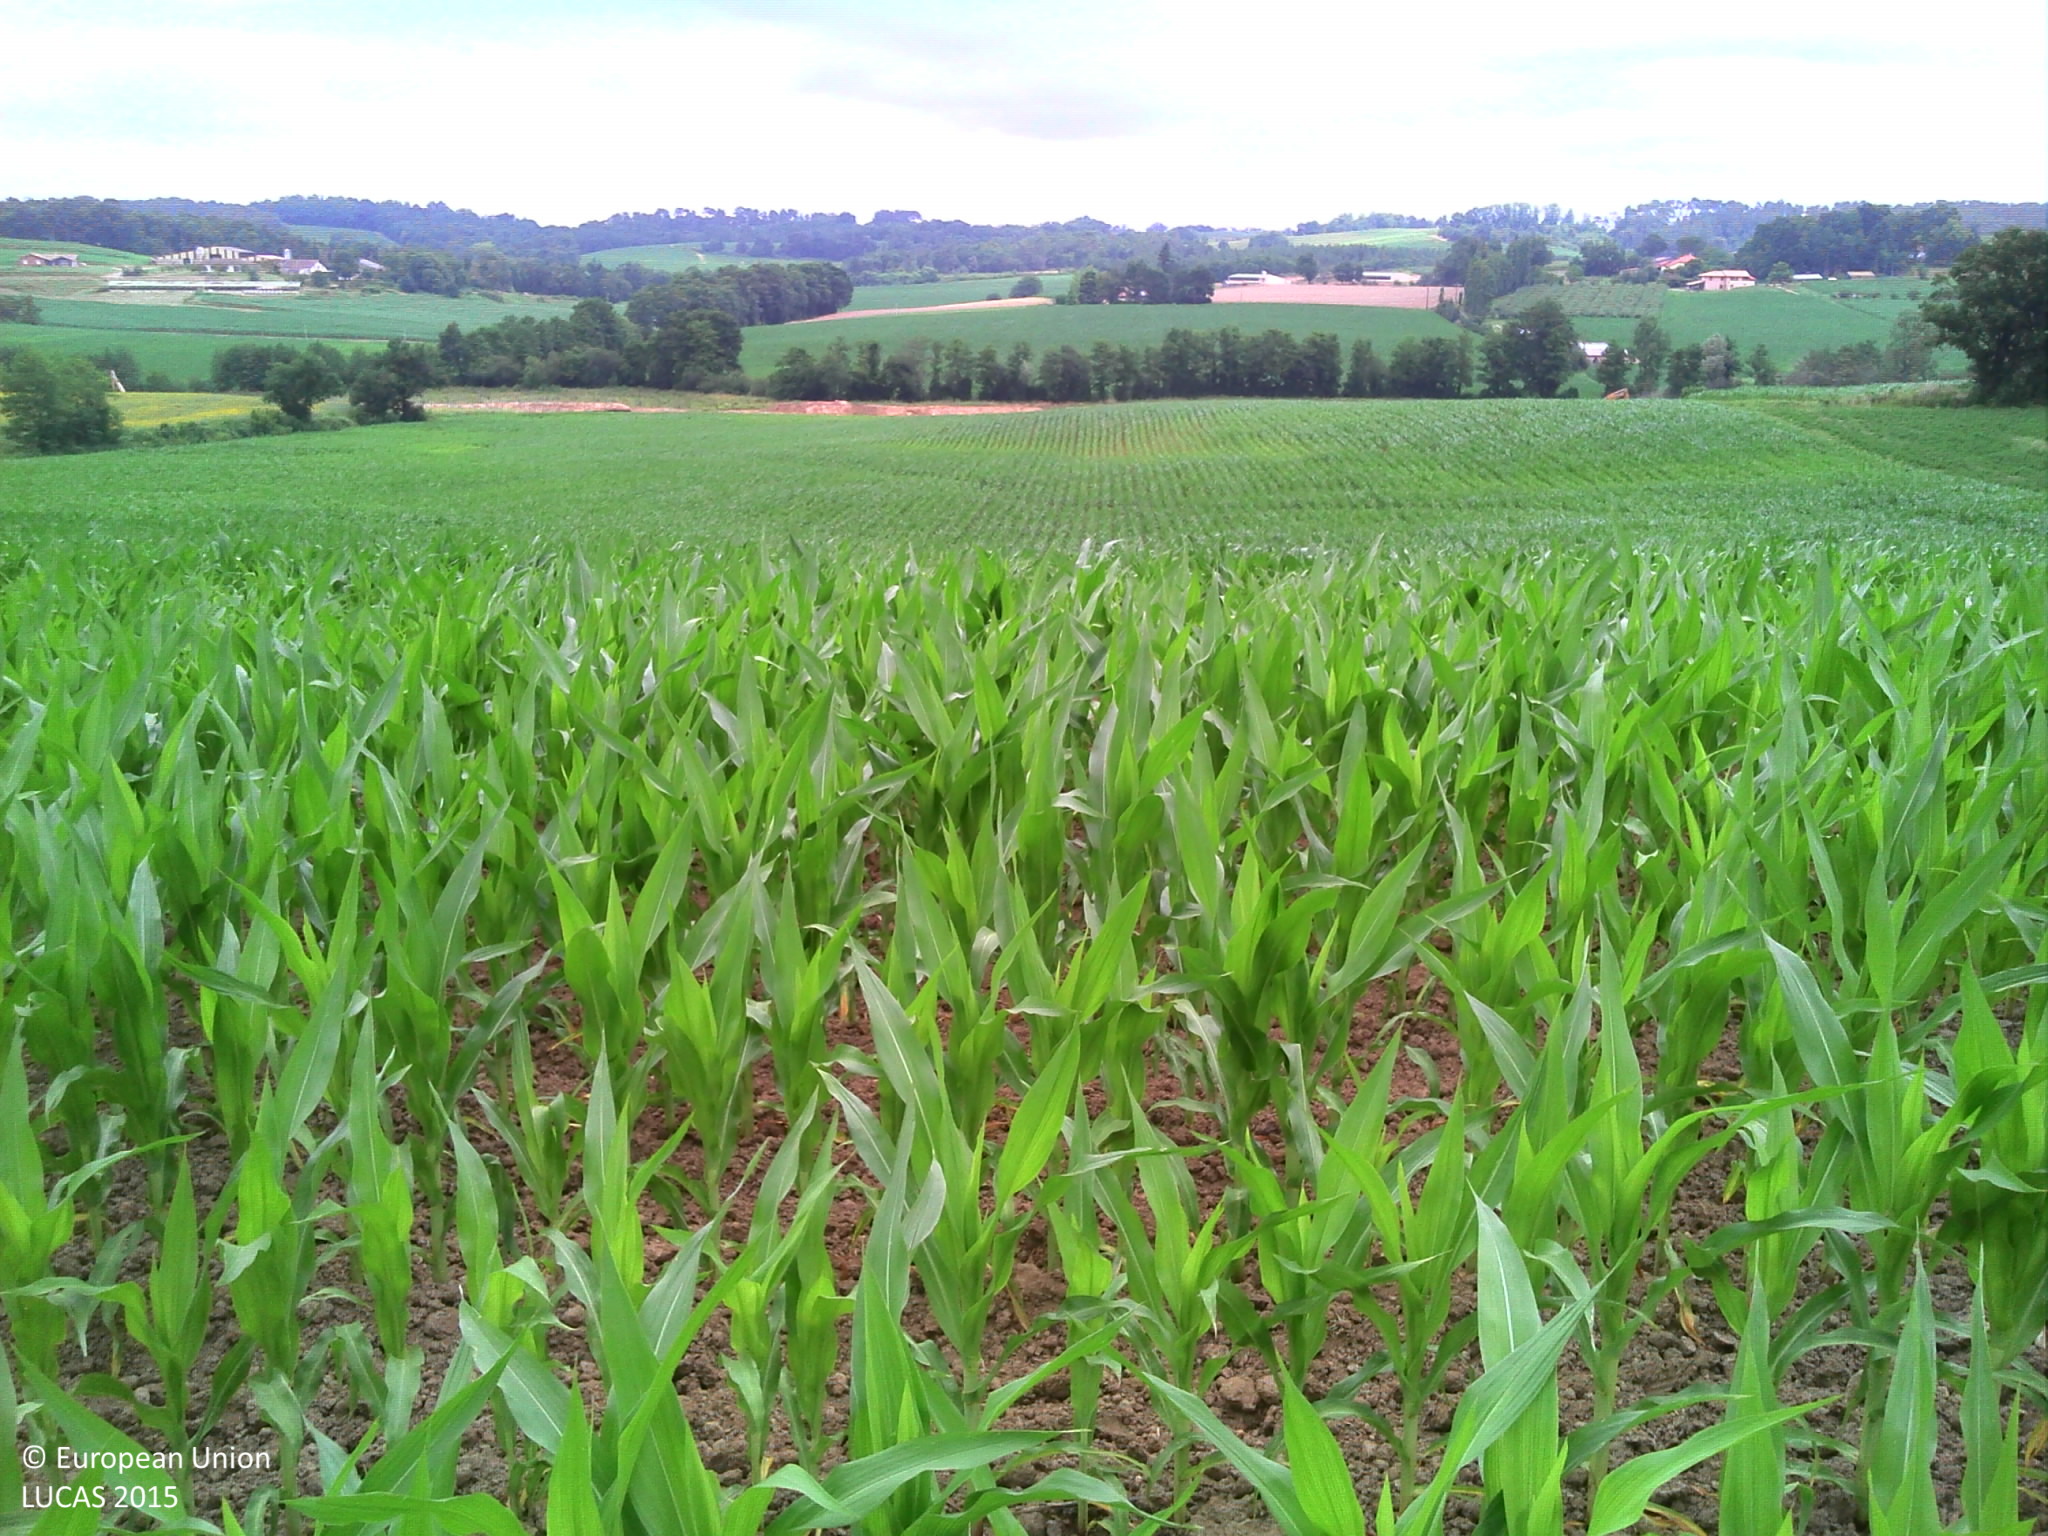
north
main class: Cropland
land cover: Maize
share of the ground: 50 - 75 %
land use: Agriculture (excluding fallow land and kitchen gardens)
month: July
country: FR
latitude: 43.6465
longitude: -0.7361
